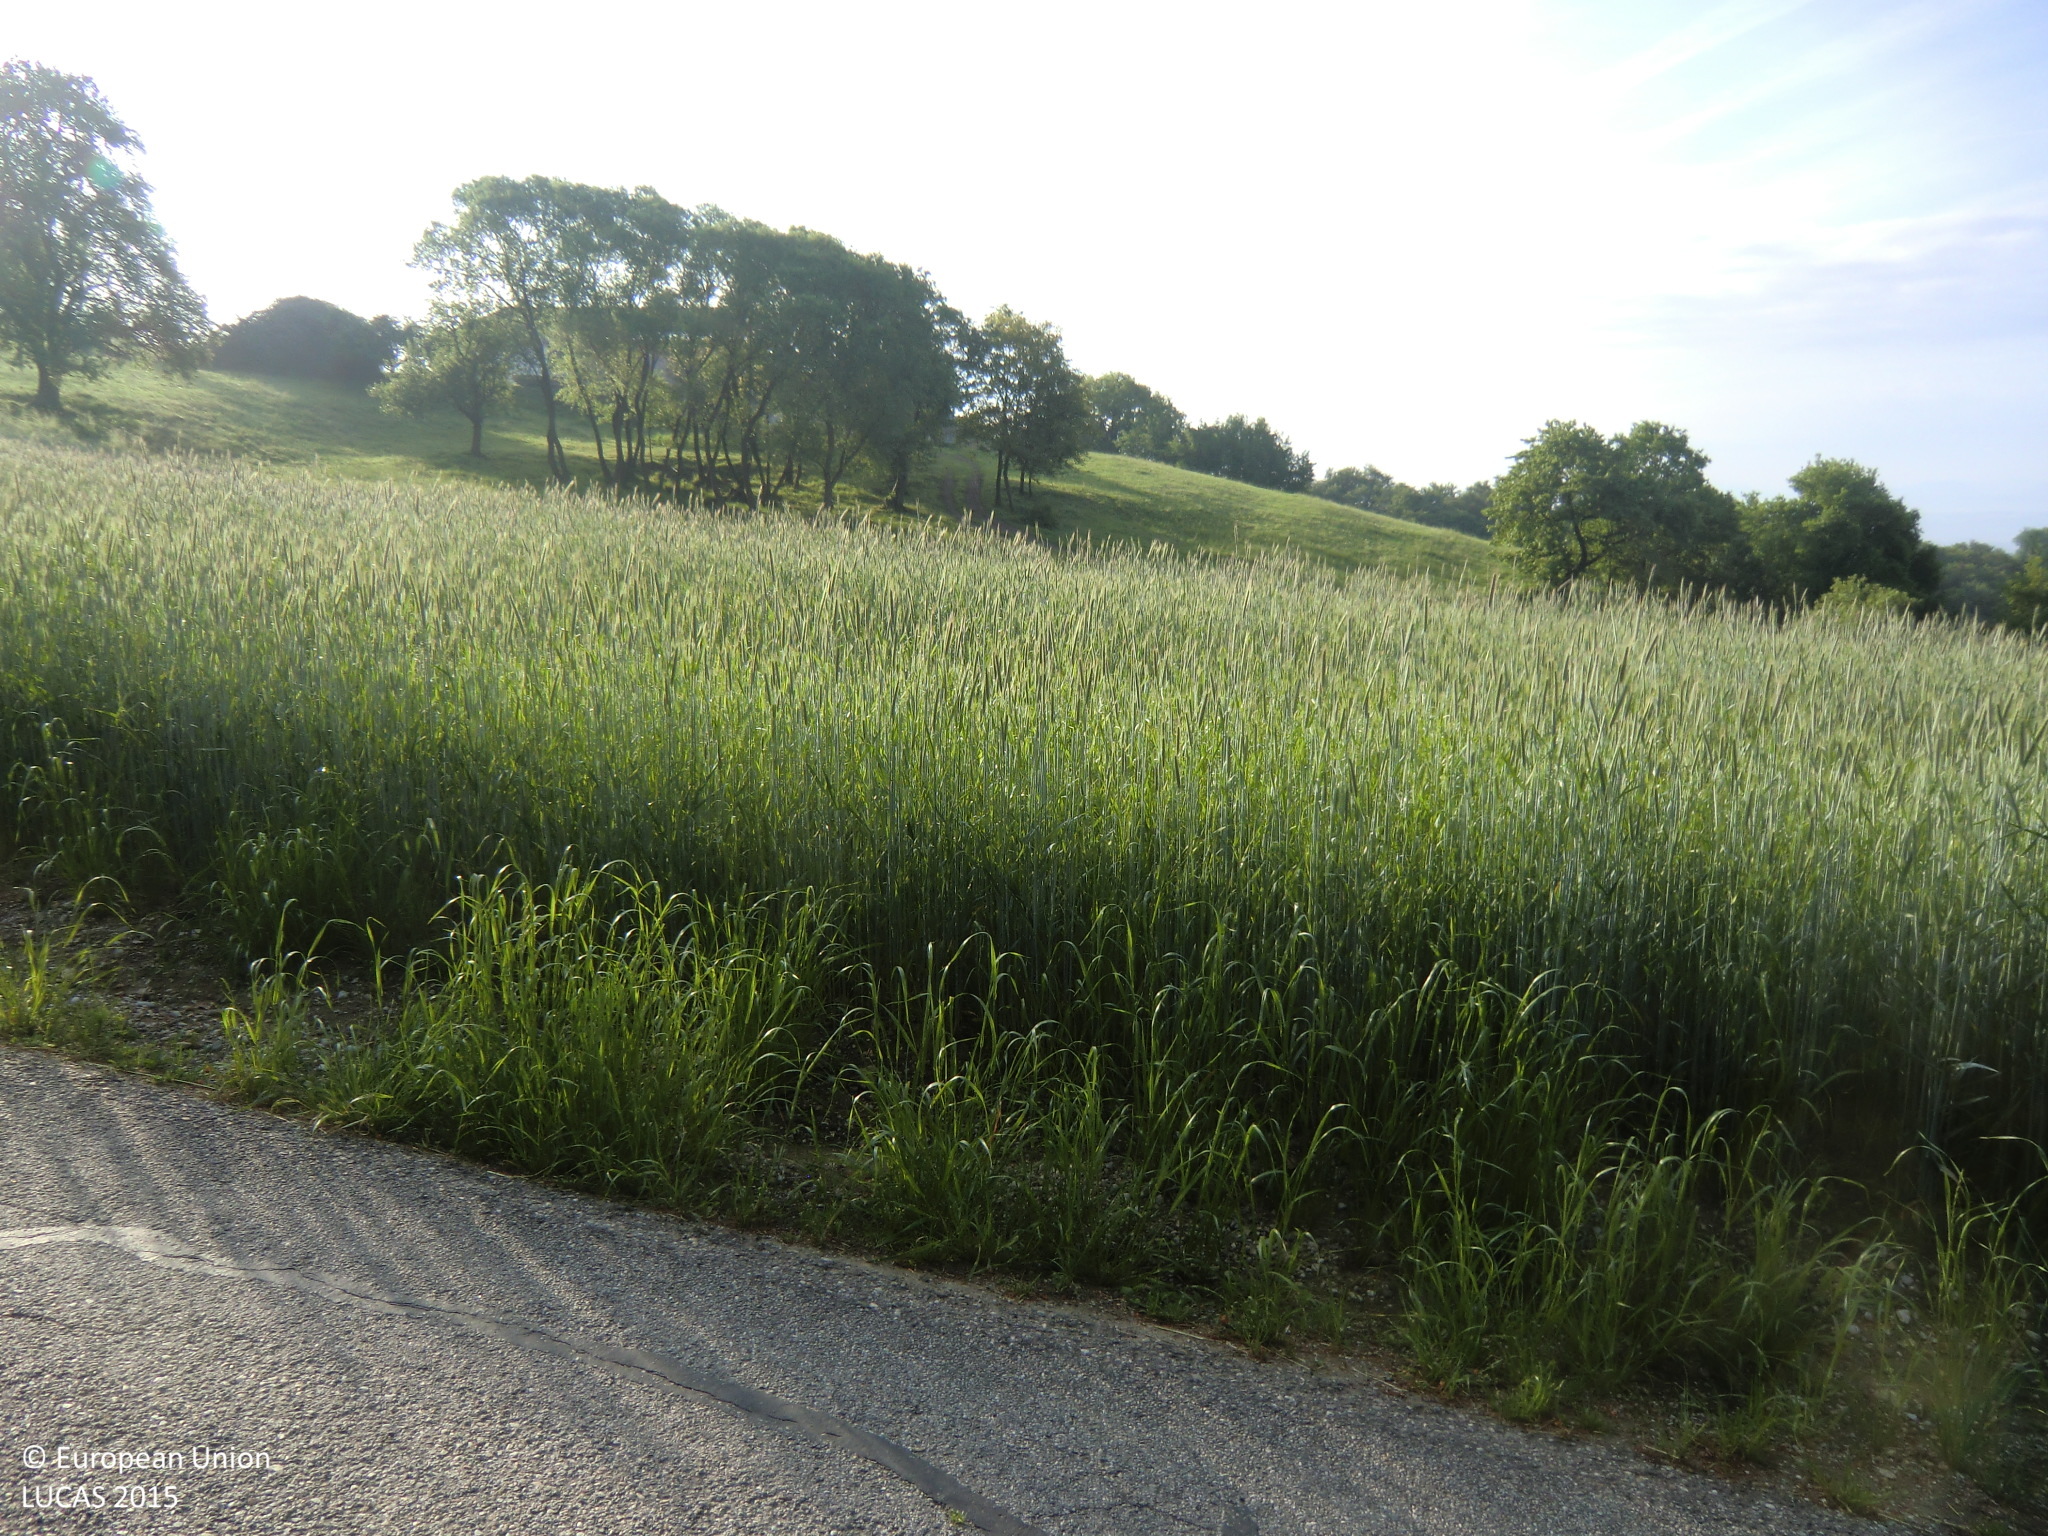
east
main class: Woodland
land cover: Spruce dominated mixed woodland
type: hemiboreal forest and nemoral coniferous forest and mixed broadleaved-coniferous forest
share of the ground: > 75 %
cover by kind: coniferous forest trees 40 %, broadleaved forest trees 40 %, herbaceous plants 20 %
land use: Forestry
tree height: > 5 m
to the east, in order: Spruce dominated mixed woodland; Grass margins; Paved roads, cycling and walking lanes; Rye; Fences; Grassland without tree/shrub cover; Fences; Grass margins; Paved roads, cycling and walking lanes; Grassland without tree/shrub cover; Abandoned hedges; Rye
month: May
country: AT
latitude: 48.2888
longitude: 14.6235
